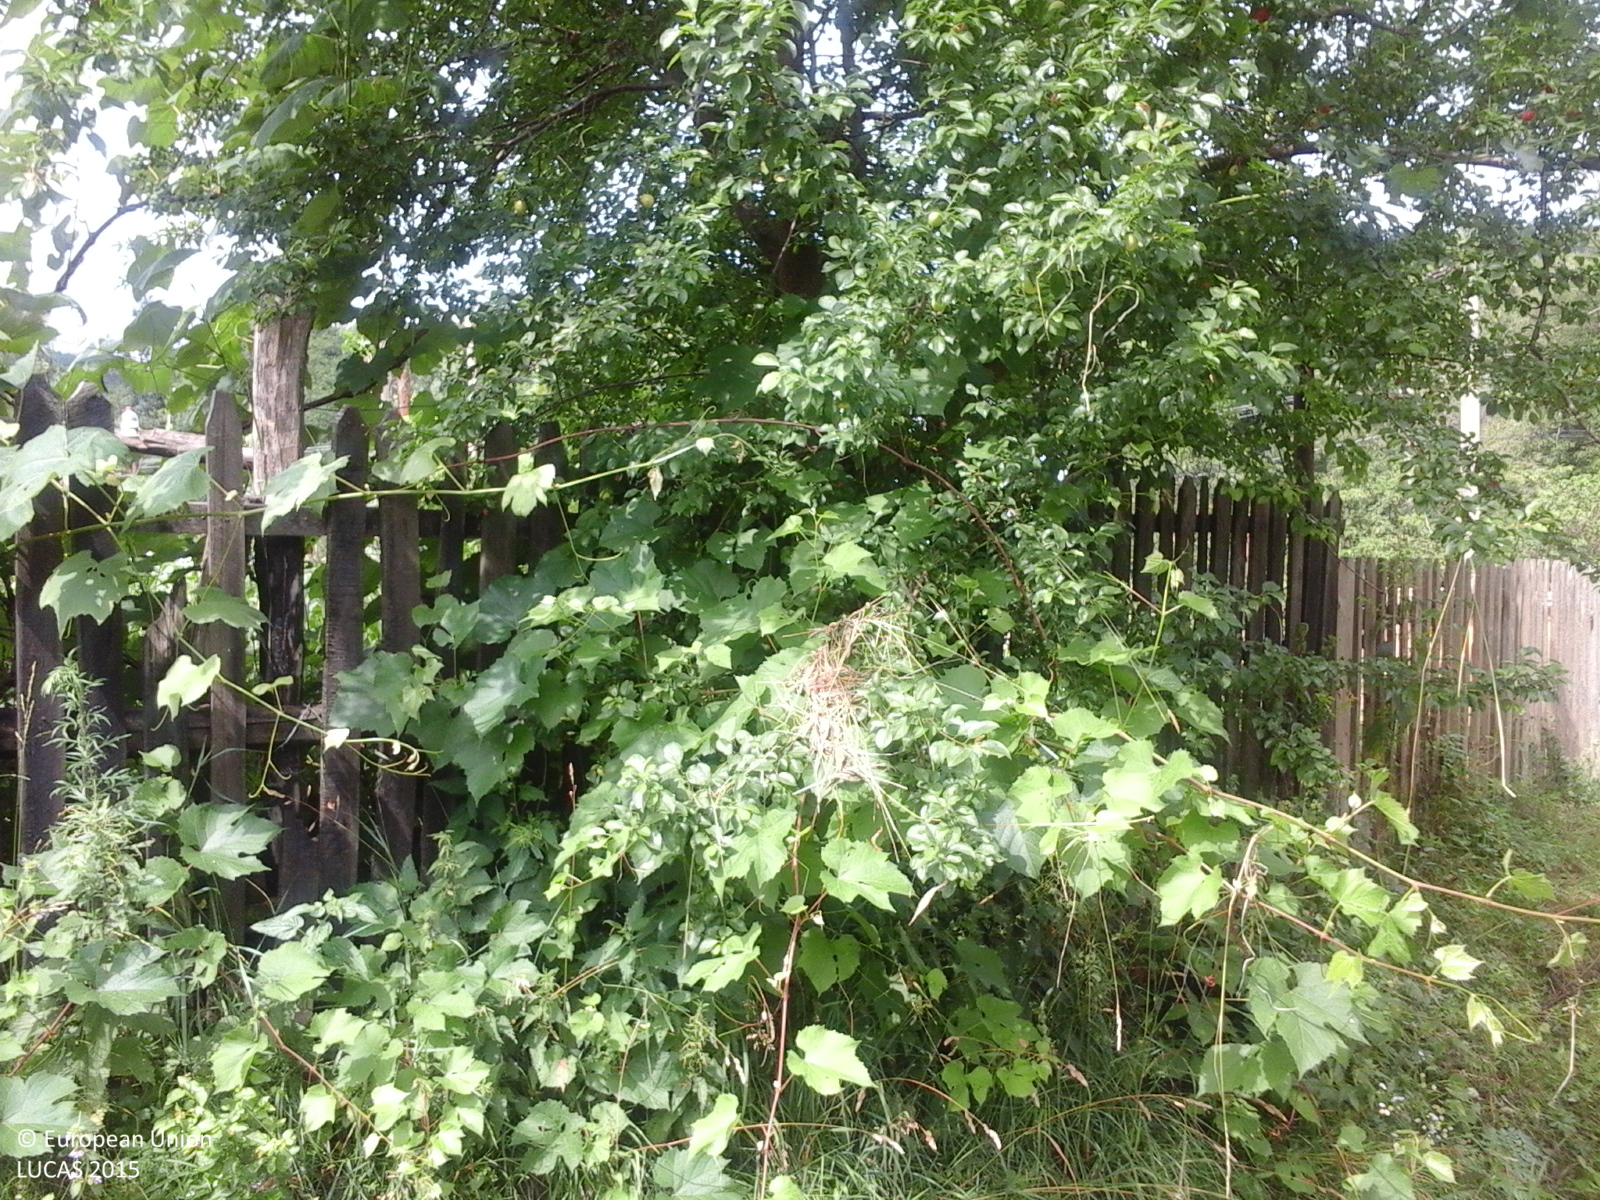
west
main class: Cropland
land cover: Apple fruit
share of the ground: > 75 %
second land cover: Grassland without tree/shrub cover
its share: > 75 %
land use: Agriculture (excluding fallow land and kitchen gardens)
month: July
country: RO
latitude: 45.1995
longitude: 24.7081
